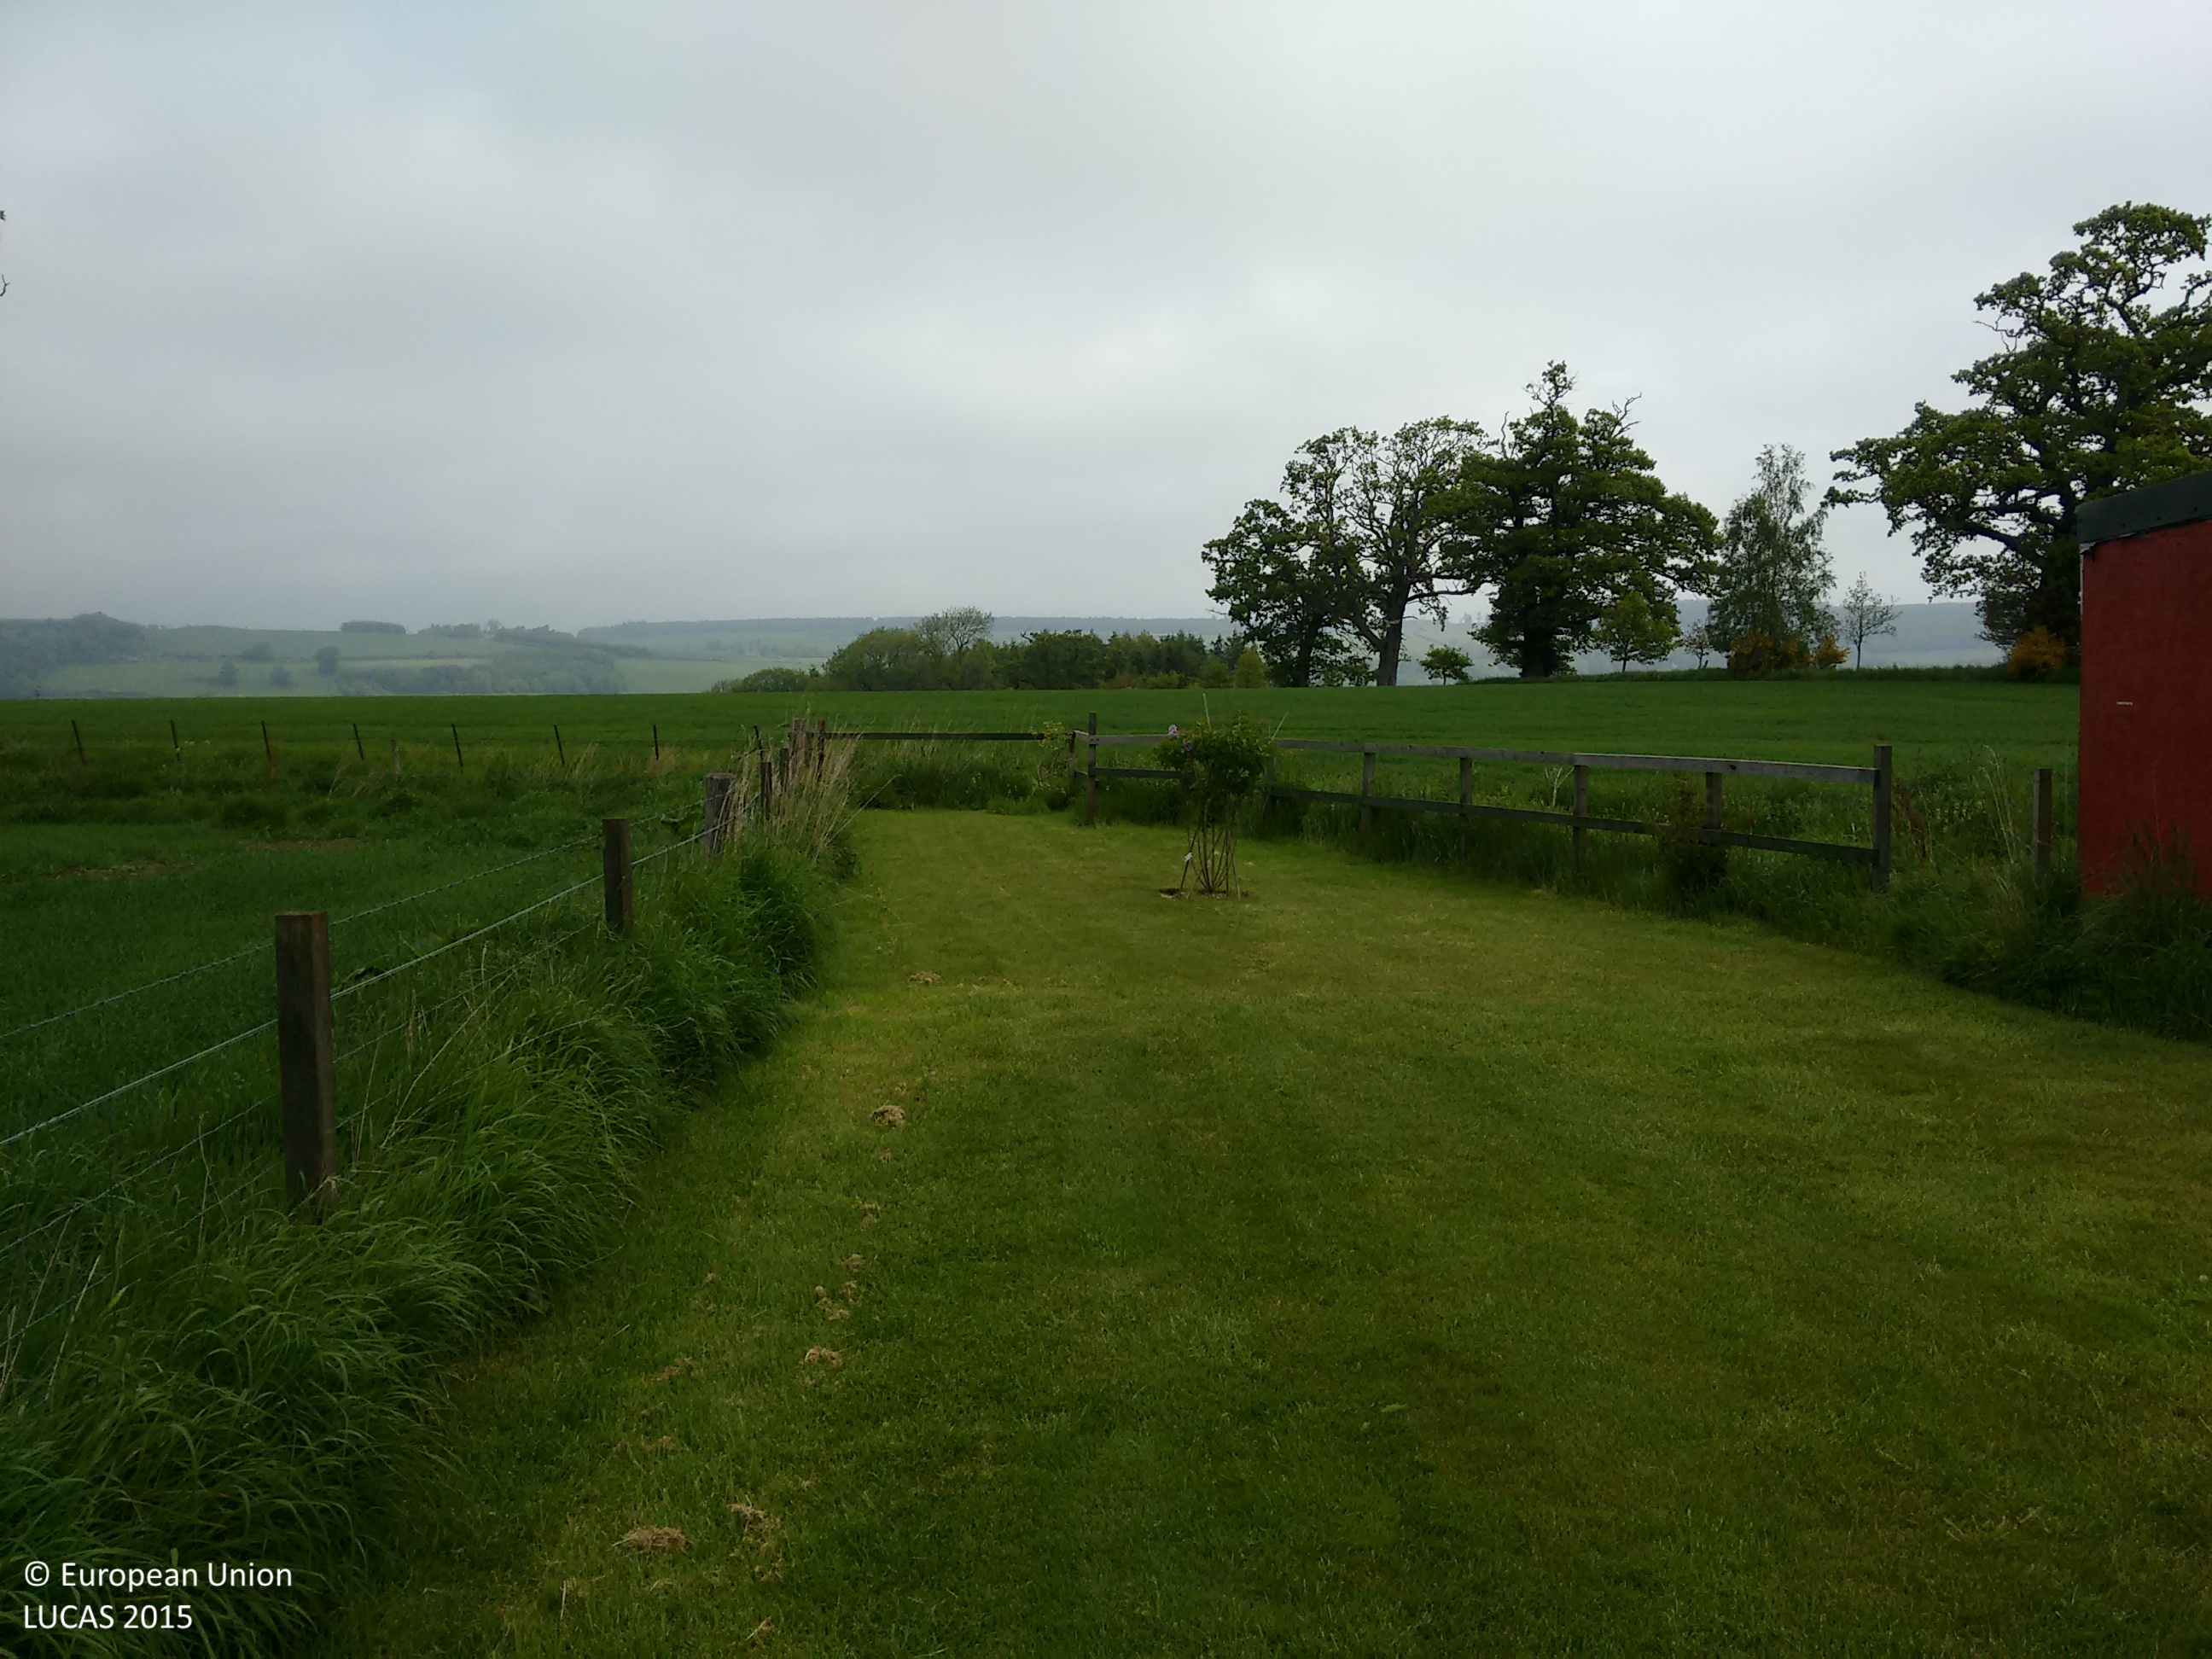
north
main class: Grassland
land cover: Grassland without tree/shrub cover
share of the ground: > 75 %
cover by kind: herbaceous plants 100 %
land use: Residential
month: June
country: GB
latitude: 56.3476
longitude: -3.4891
